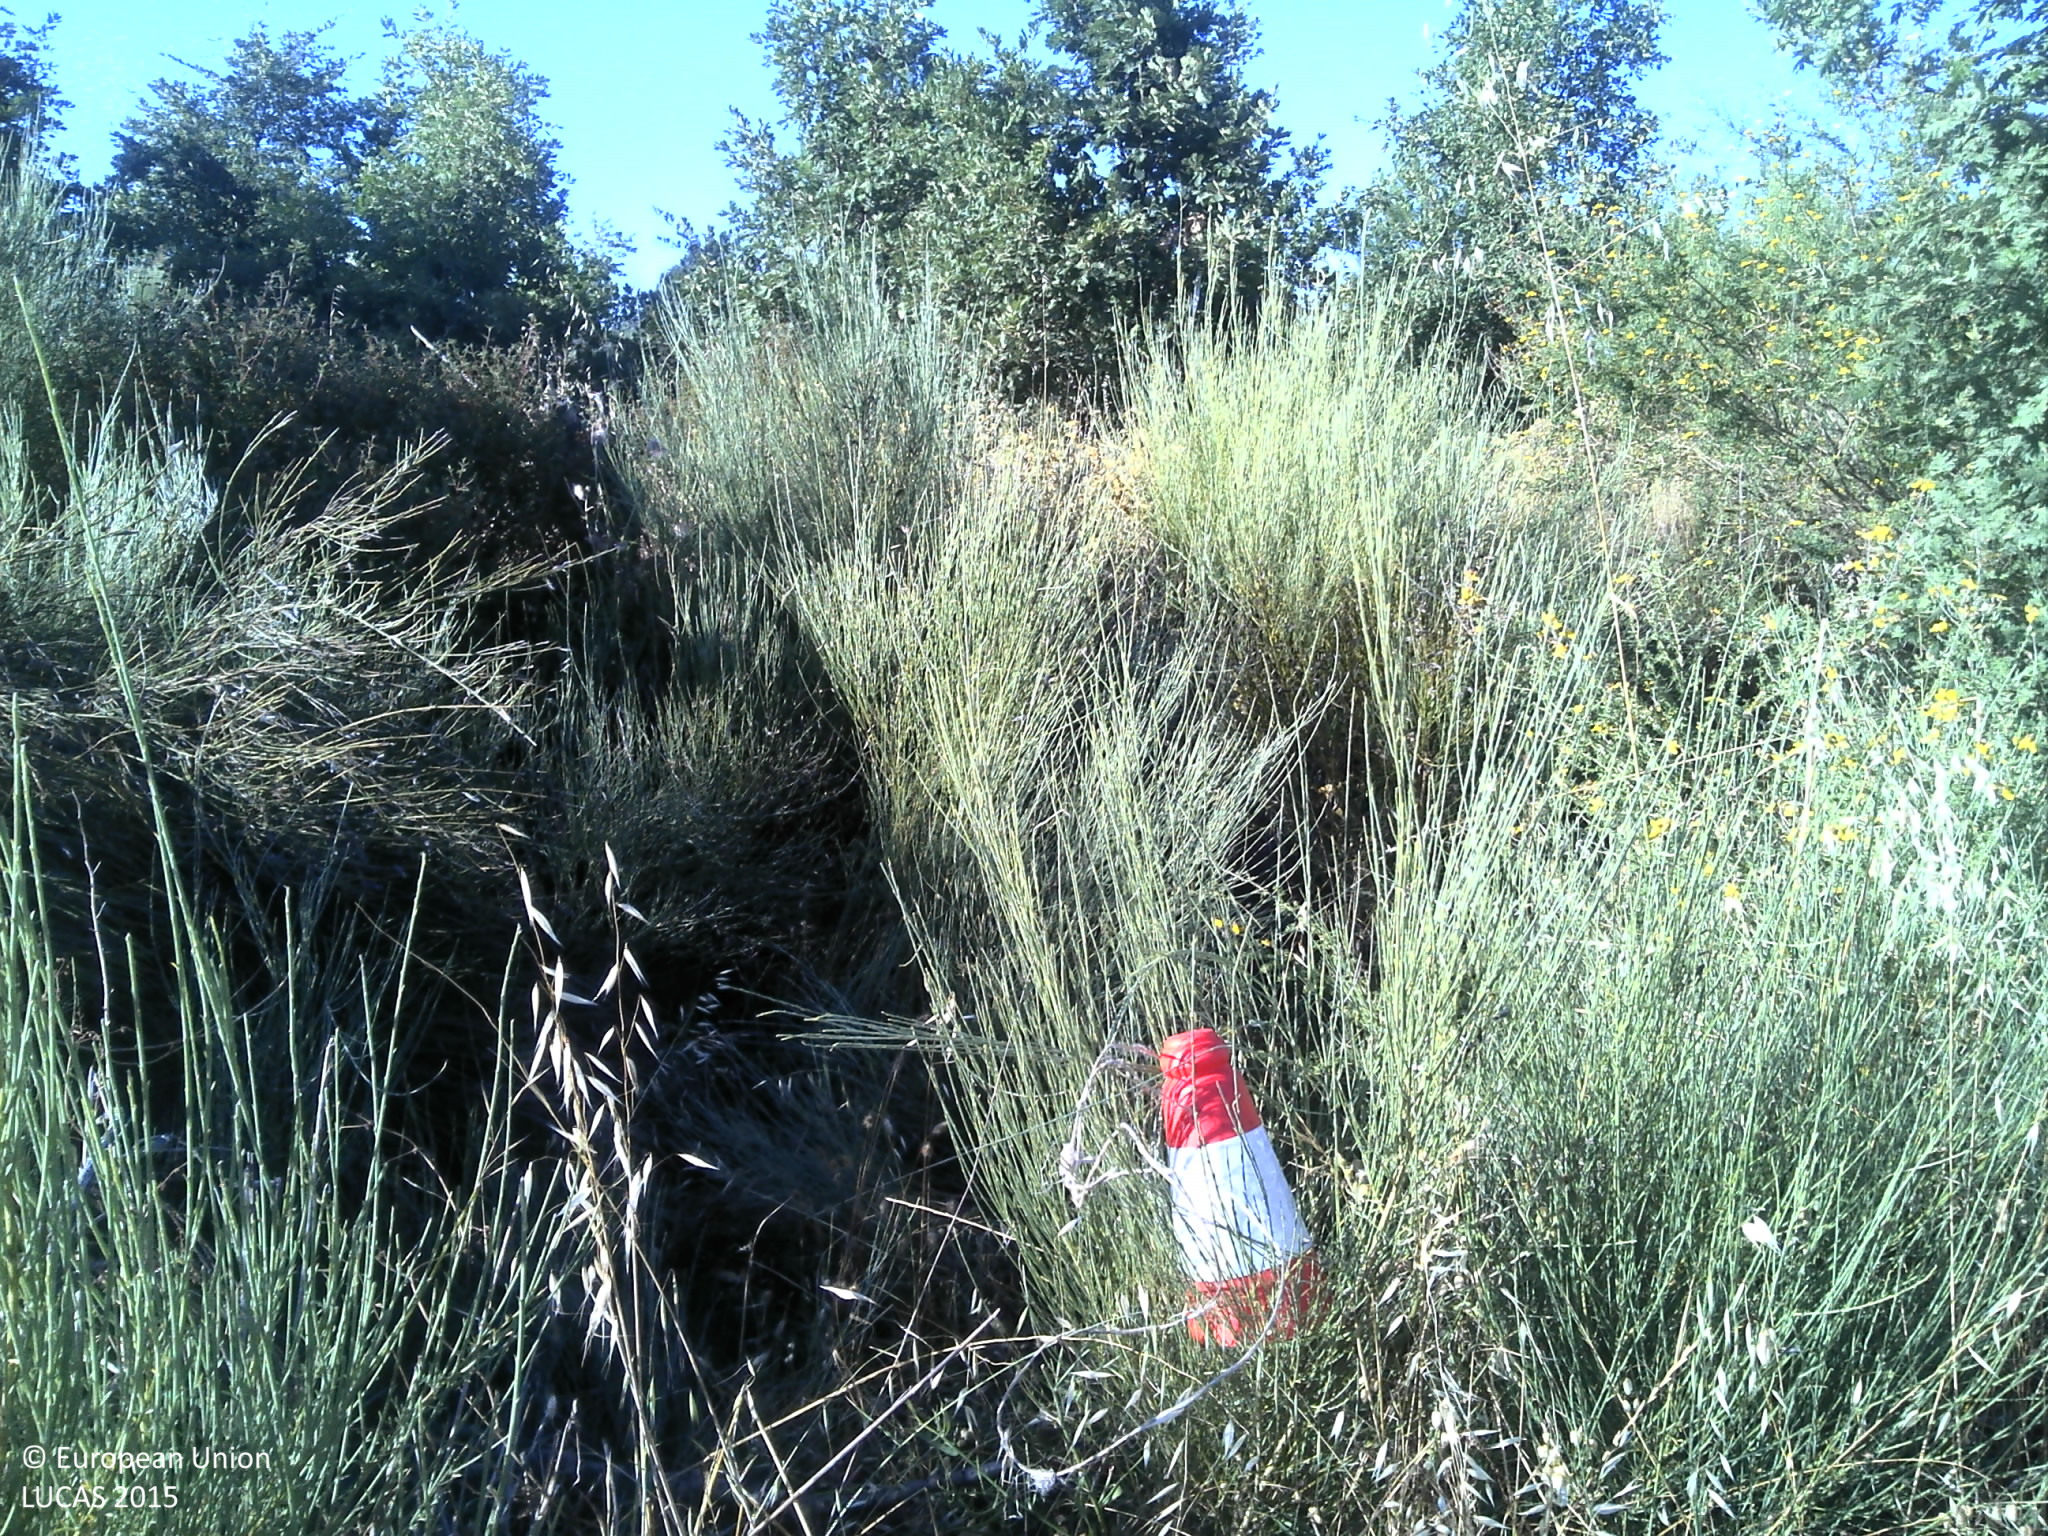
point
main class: Shrubland
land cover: Shrubland with sparse tree cover
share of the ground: 50 - 75 %
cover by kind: shrubs 65 %, unconsolidated bare surface 25 %, broadleaved forest trees 5 %, herbaceous plants 5 %
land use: Forestry
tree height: < 5 m
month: June
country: PT
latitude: 40.0749
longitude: -7.4452
